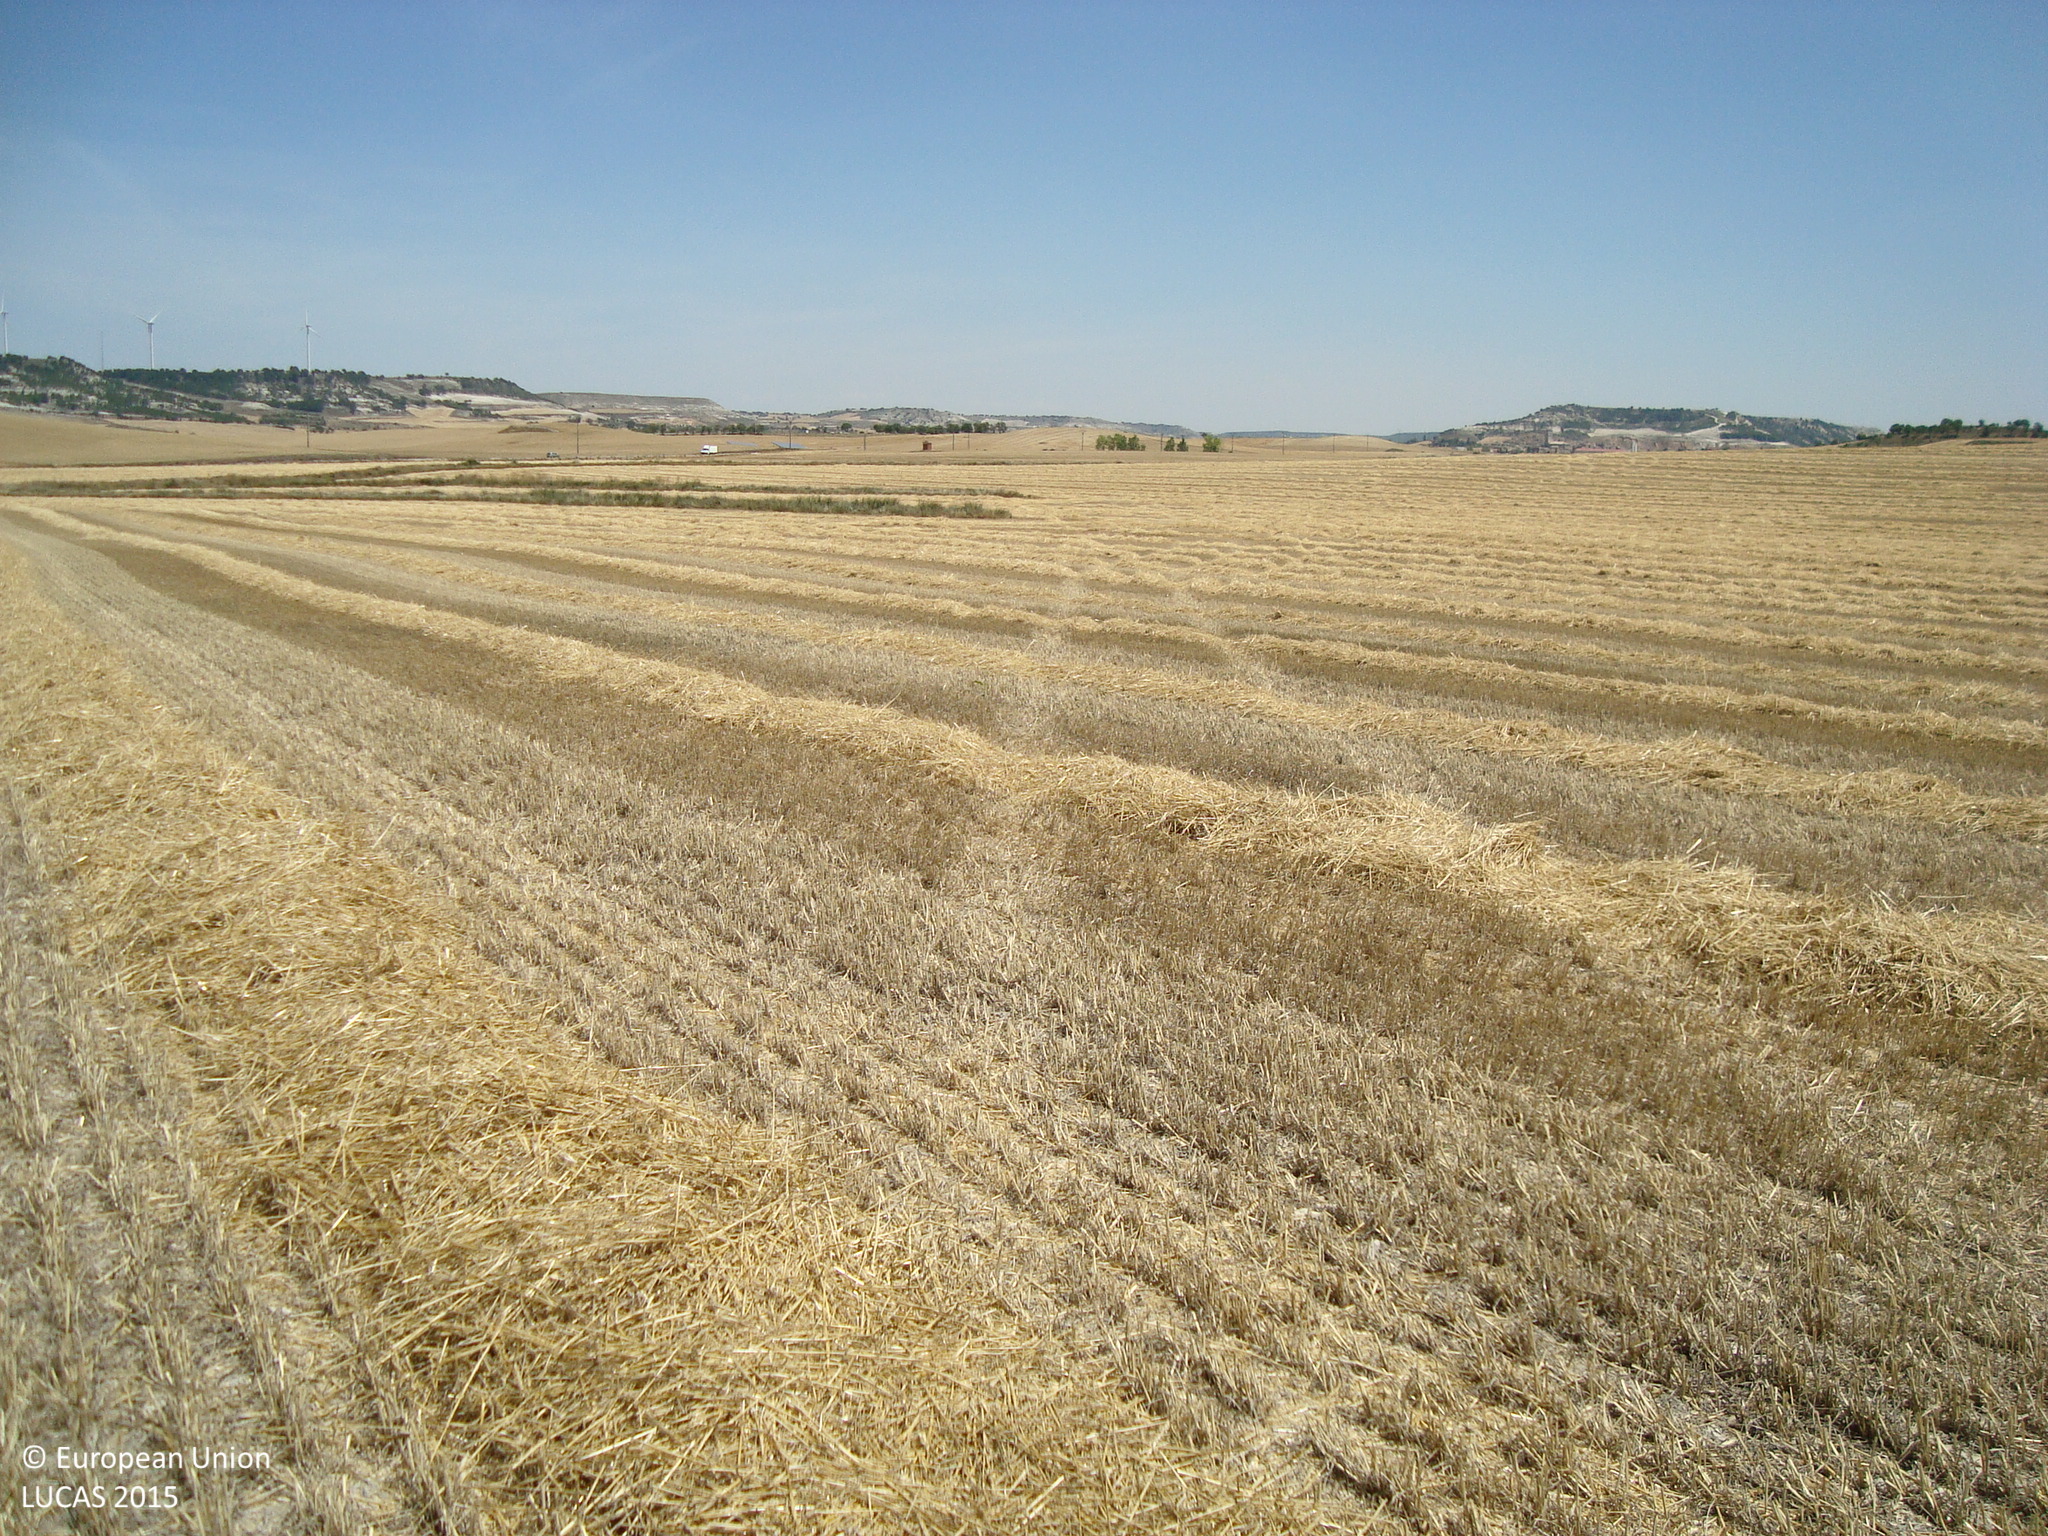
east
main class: Cropland
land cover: Common wheat
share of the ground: < 10 %
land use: Agriculture (excluding fallow land and kitchen gardens)
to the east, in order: Common wheat
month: July
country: ES
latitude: 41.9466
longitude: -4.2872
